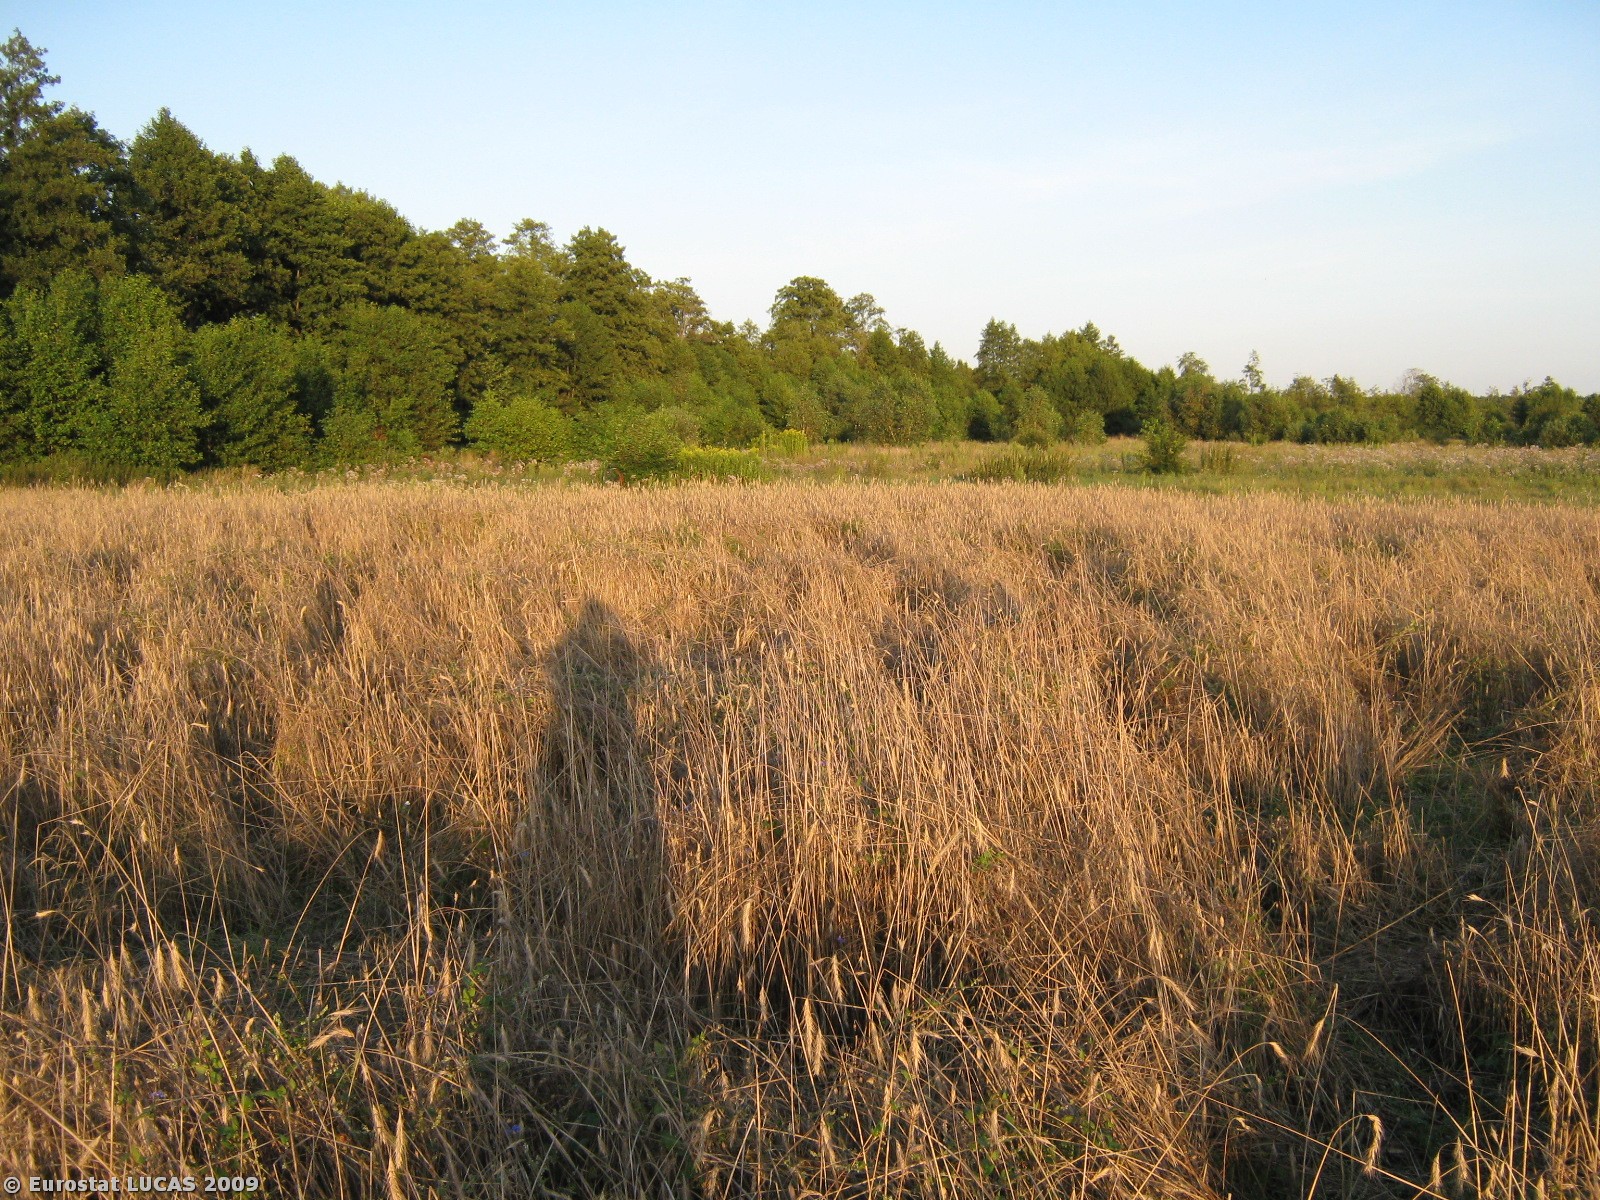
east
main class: Cropland
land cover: Rye
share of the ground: > 75 %
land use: Agriculture (excluding fallow land and kitchen gardens)
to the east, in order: Rye; Grassland with sparse tree/shrub cover; Broadleaved woodland; Inland water bodies; Inland marshes; Broadleaved woodland
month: August
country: PL
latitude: 52.3710
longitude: 19.5605
